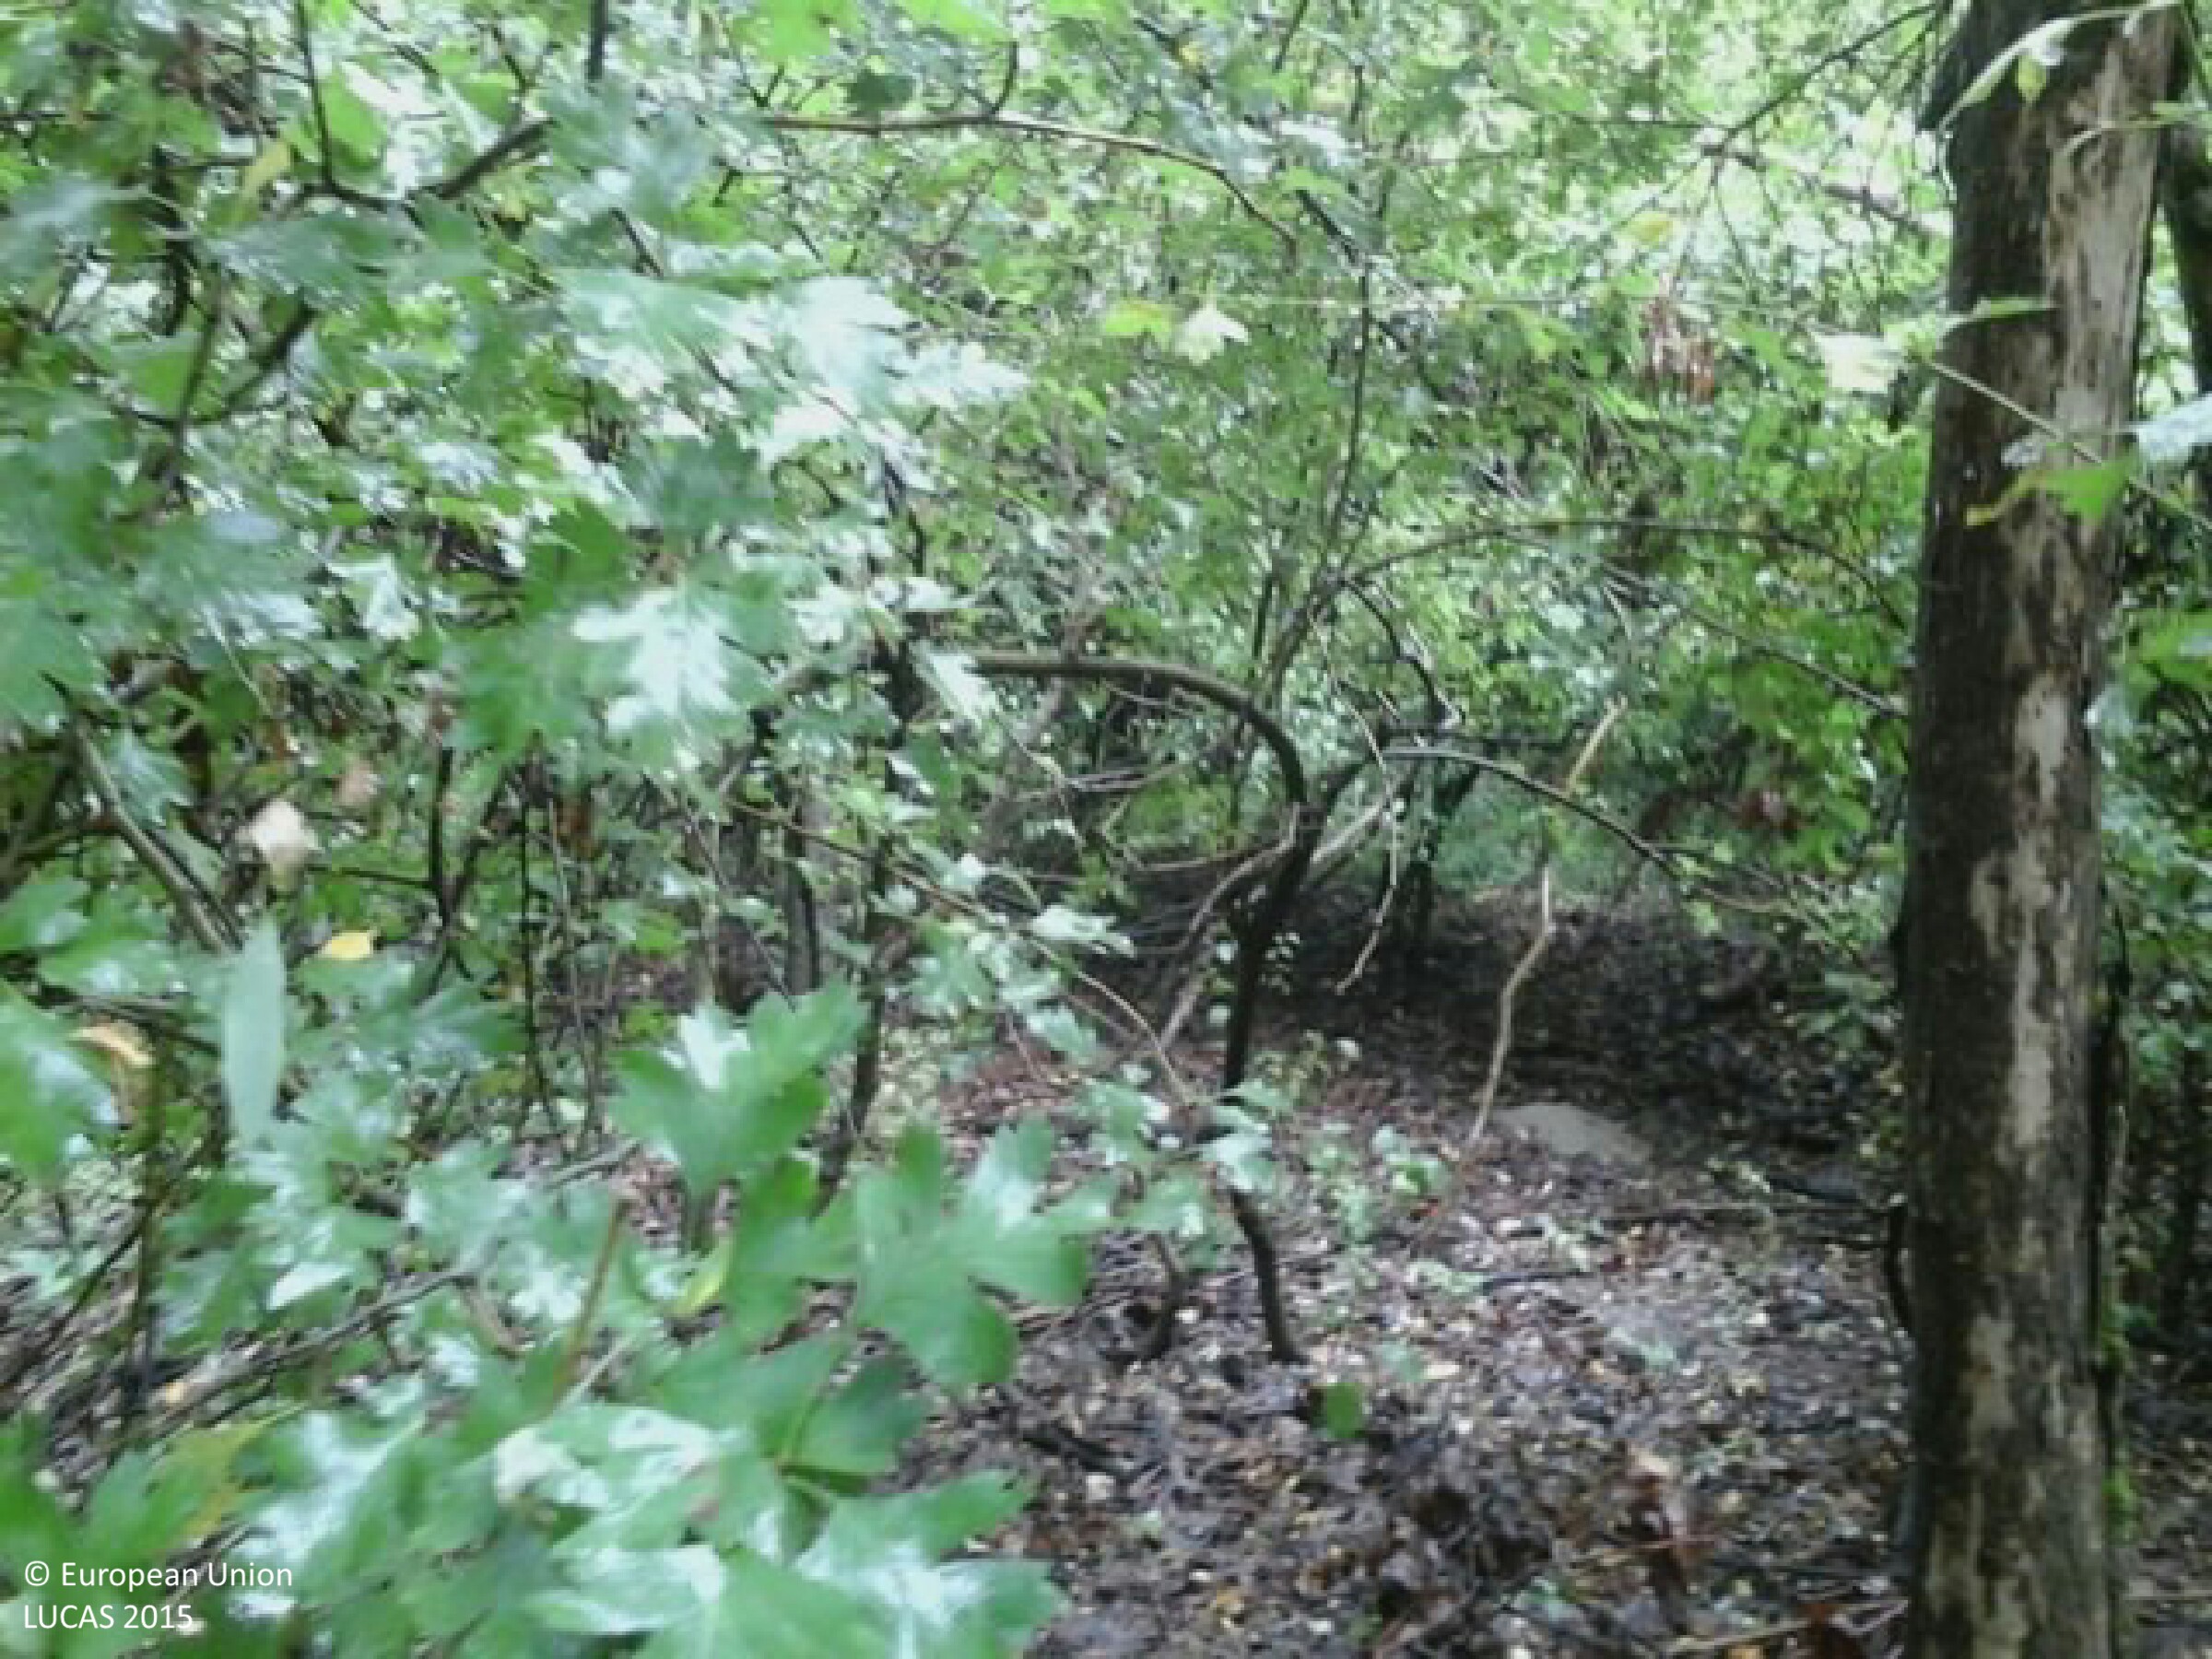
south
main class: Woodland
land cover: Broadleaved woodland
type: thermophilous deciduous forest
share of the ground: > 75 %
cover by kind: broadleaved forest trees 70 %, shrubs 20 %, coniferous forest trees 5 %, herbaceous plants 5 %
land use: Forestry
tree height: > 5 m
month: July
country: HU
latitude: 46.4188
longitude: 18.8467
